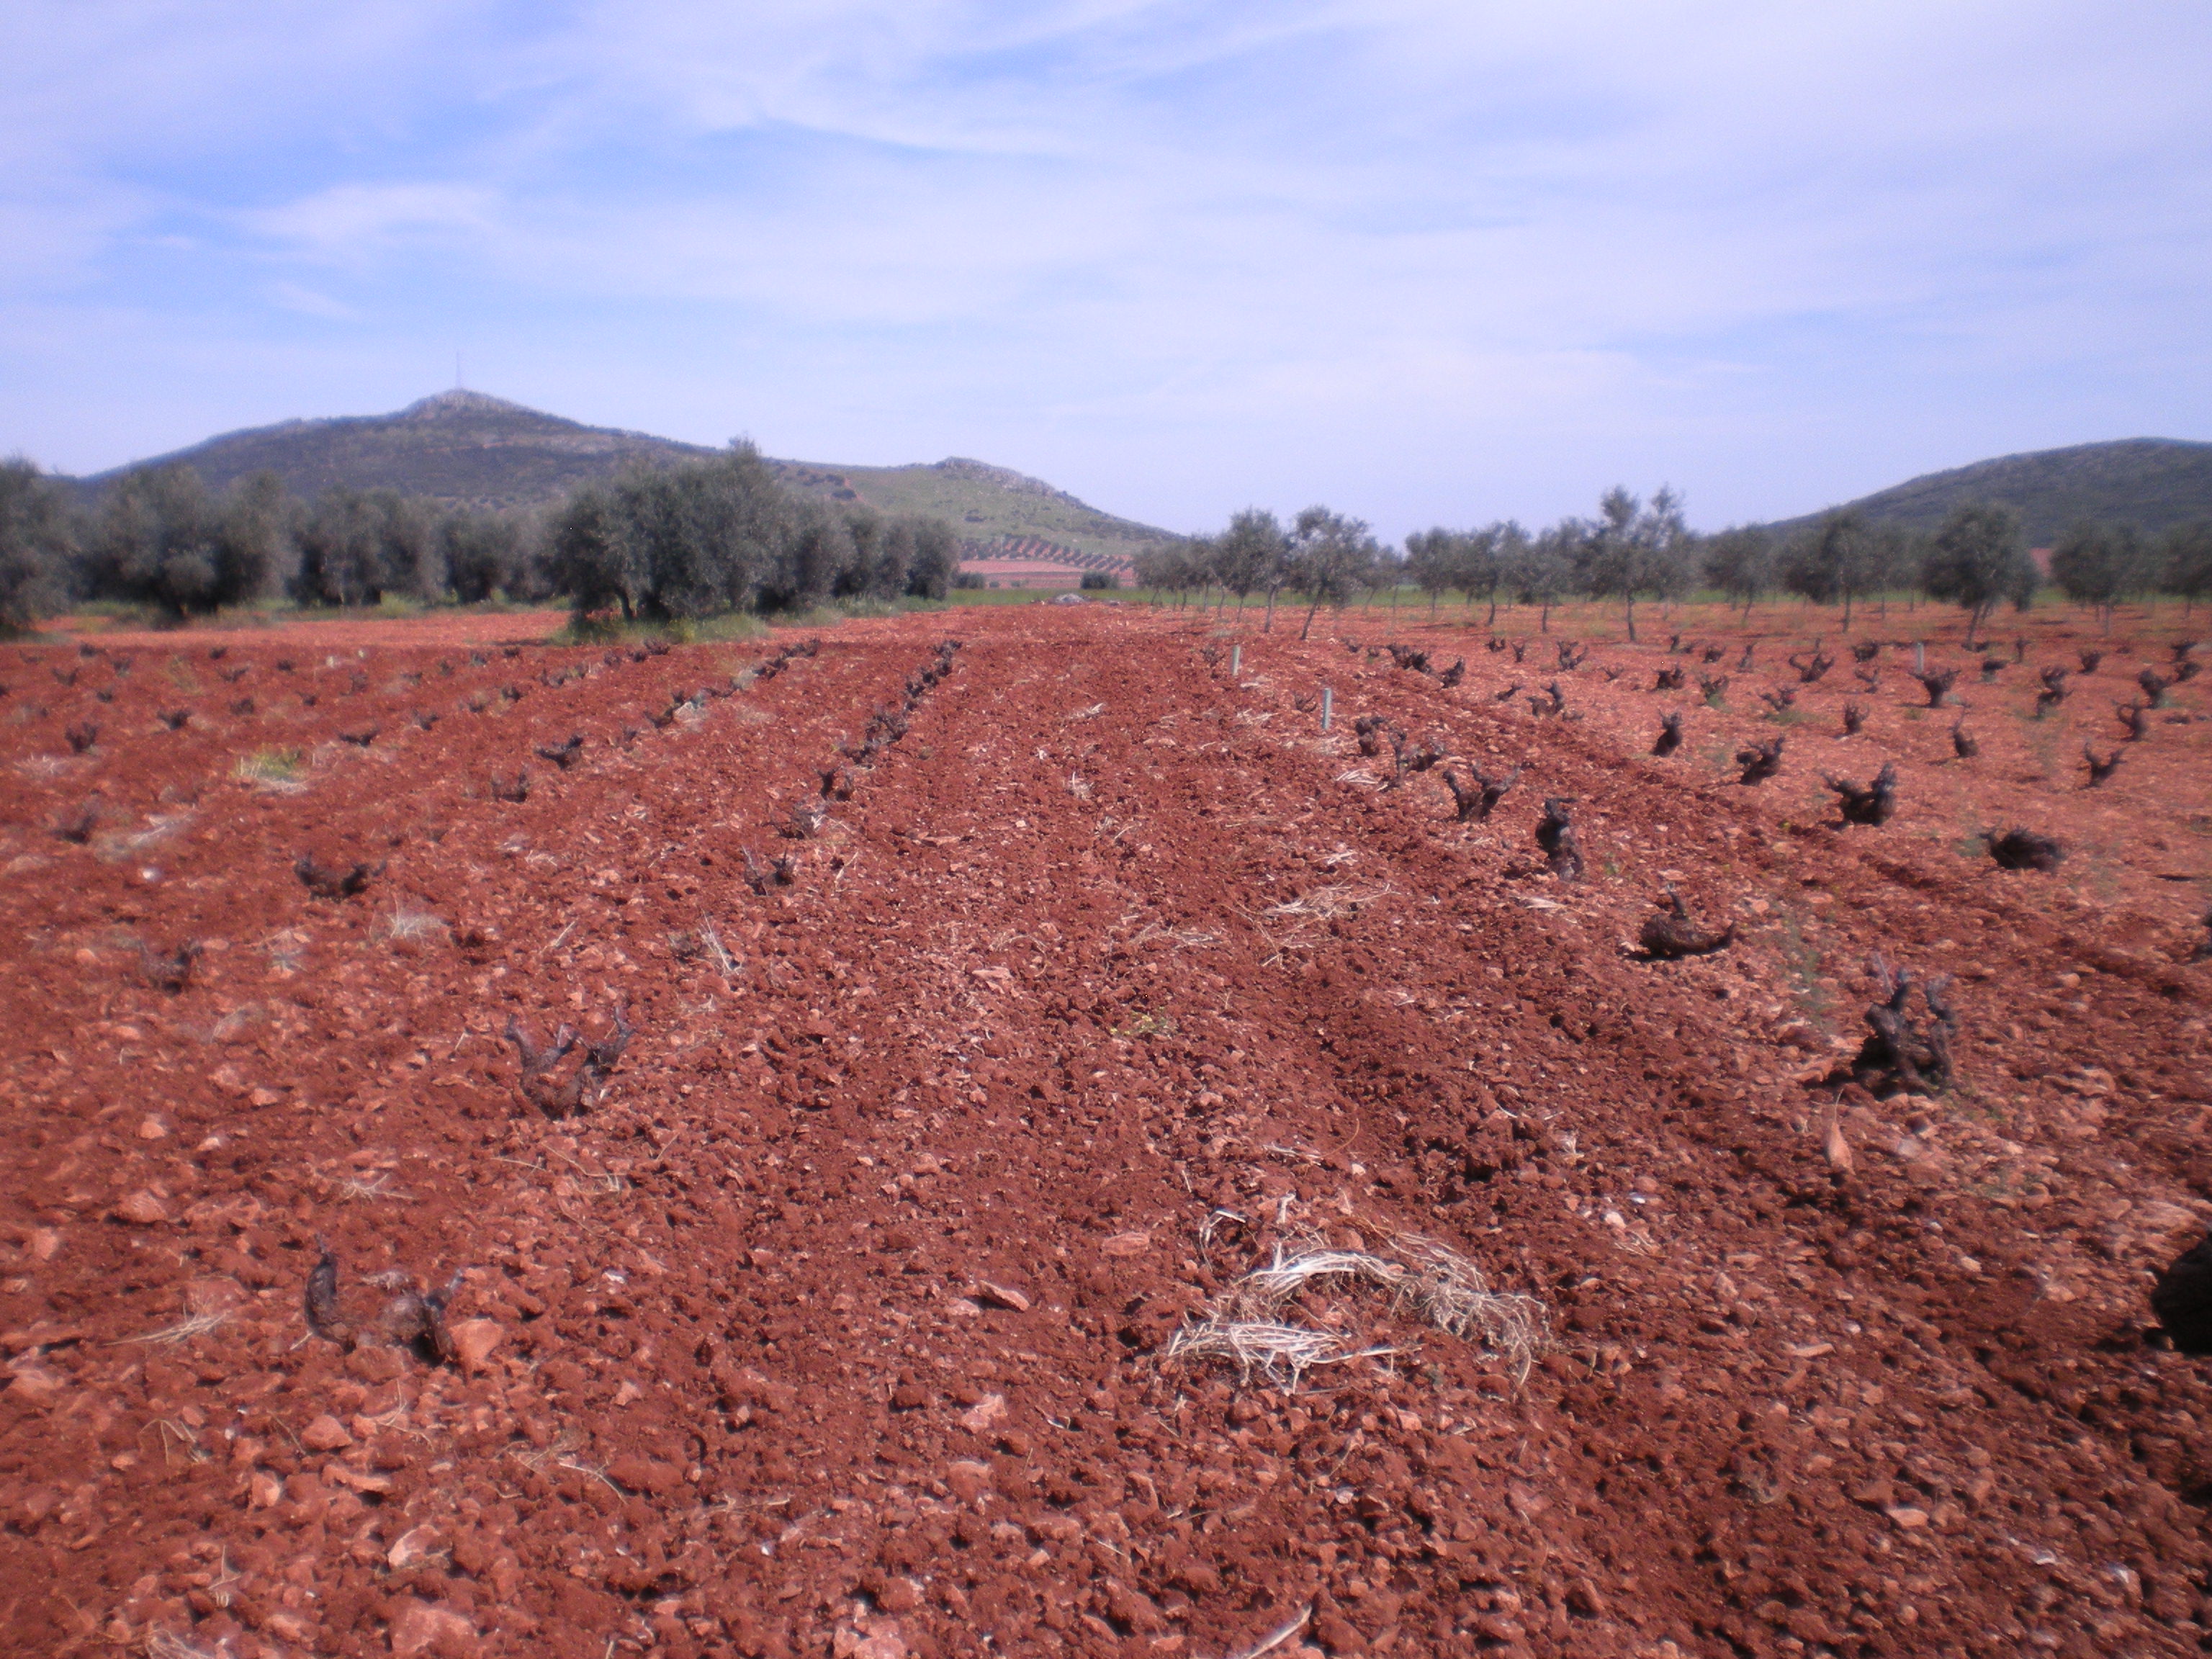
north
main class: Cropland
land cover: Vineyards
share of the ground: < 10 %
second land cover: Other bare soil
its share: > 75 %
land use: Agriculture (excluding fallow land and kitchen gardens)
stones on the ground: 10 - 25 %
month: April
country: ES
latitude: 38.8157
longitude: -3.2431
